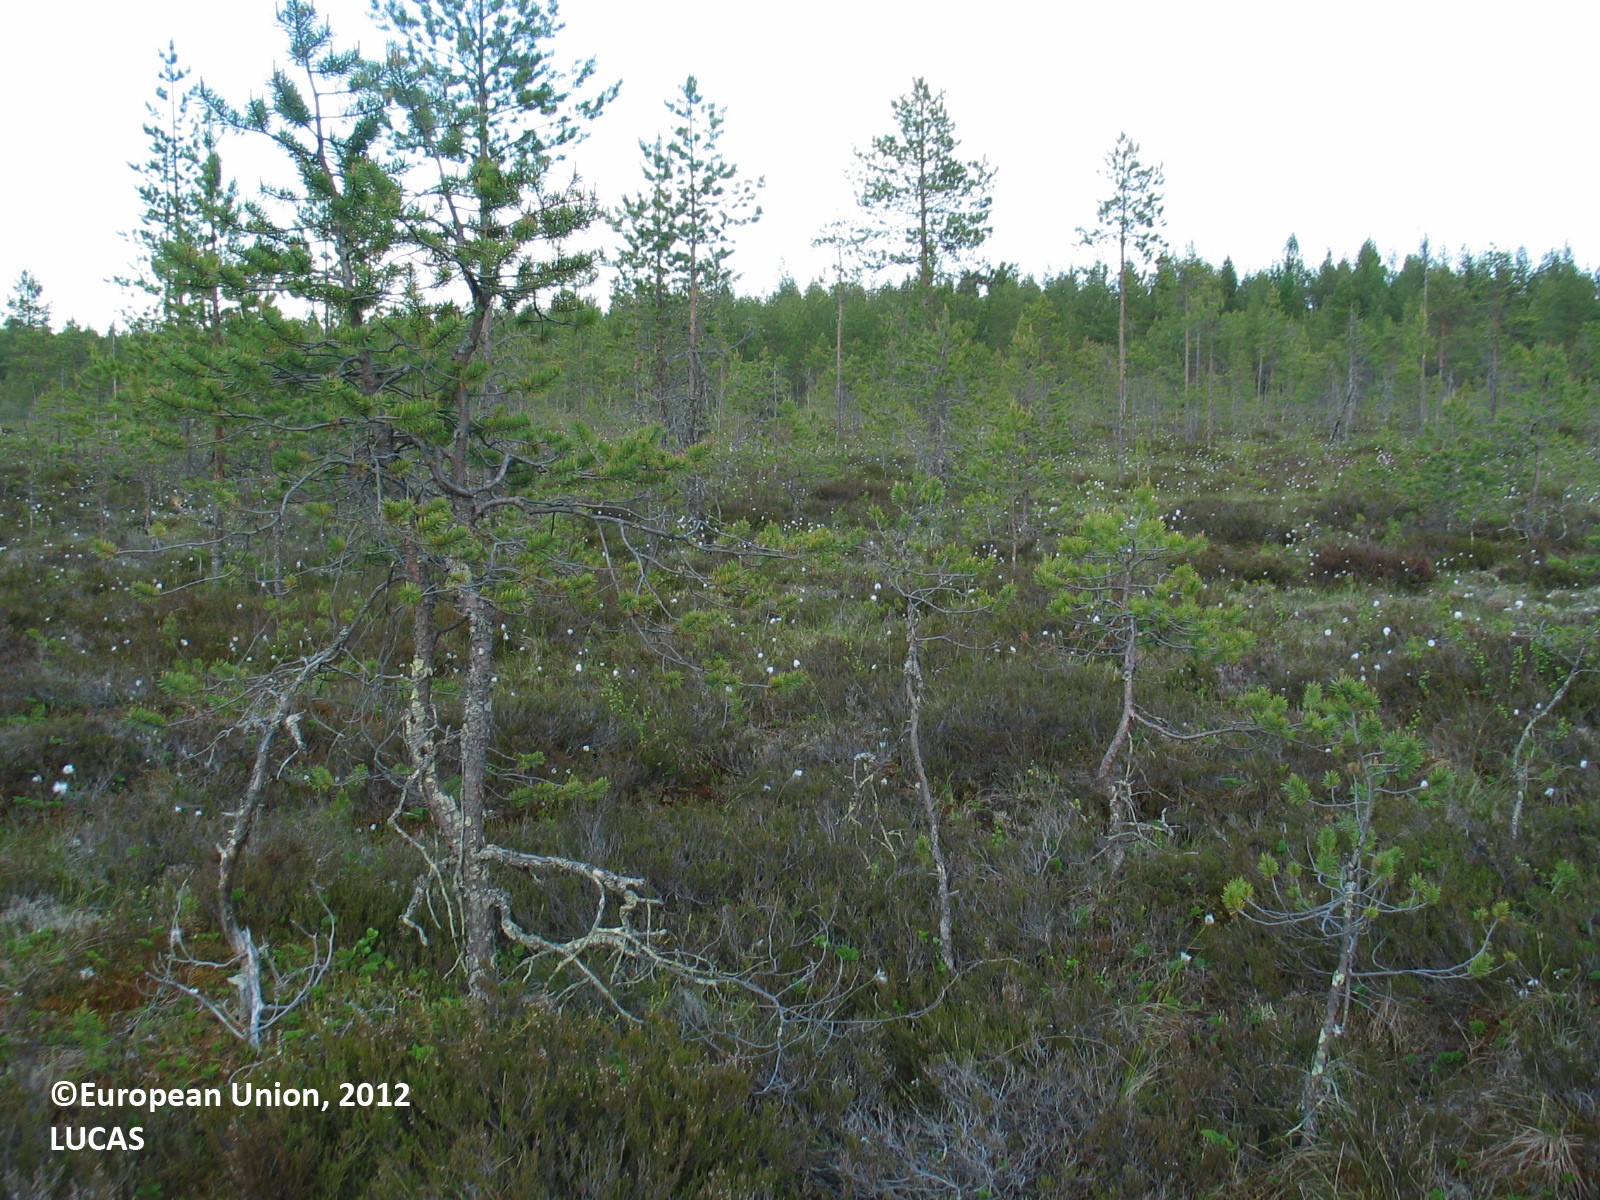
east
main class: Woodland
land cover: Pine dominated coniferous woodland
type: mire and swamp forests
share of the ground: 10 - 25 %
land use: Semi-natural and natural areas not in use
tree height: < 5 m
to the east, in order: Pine dominated coniferous woodland; Peatbogs; Pine dominated coniferous woodland; Ditches and canals; Pine dominated coniferous woodland; Ditches and canals; Pine dominated coniferous woodland; Ditches and canals; Pine dominated coniferous woodland; Ditches and canals; Pine dominated coniferous woodland; Pine dominated mixed woodland; Ditches and canals; Pine dominated mixed woodland; Ditches and canals; Pine dominated mixed woodland
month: June
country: FI
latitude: 64.8606
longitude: 26.5022
